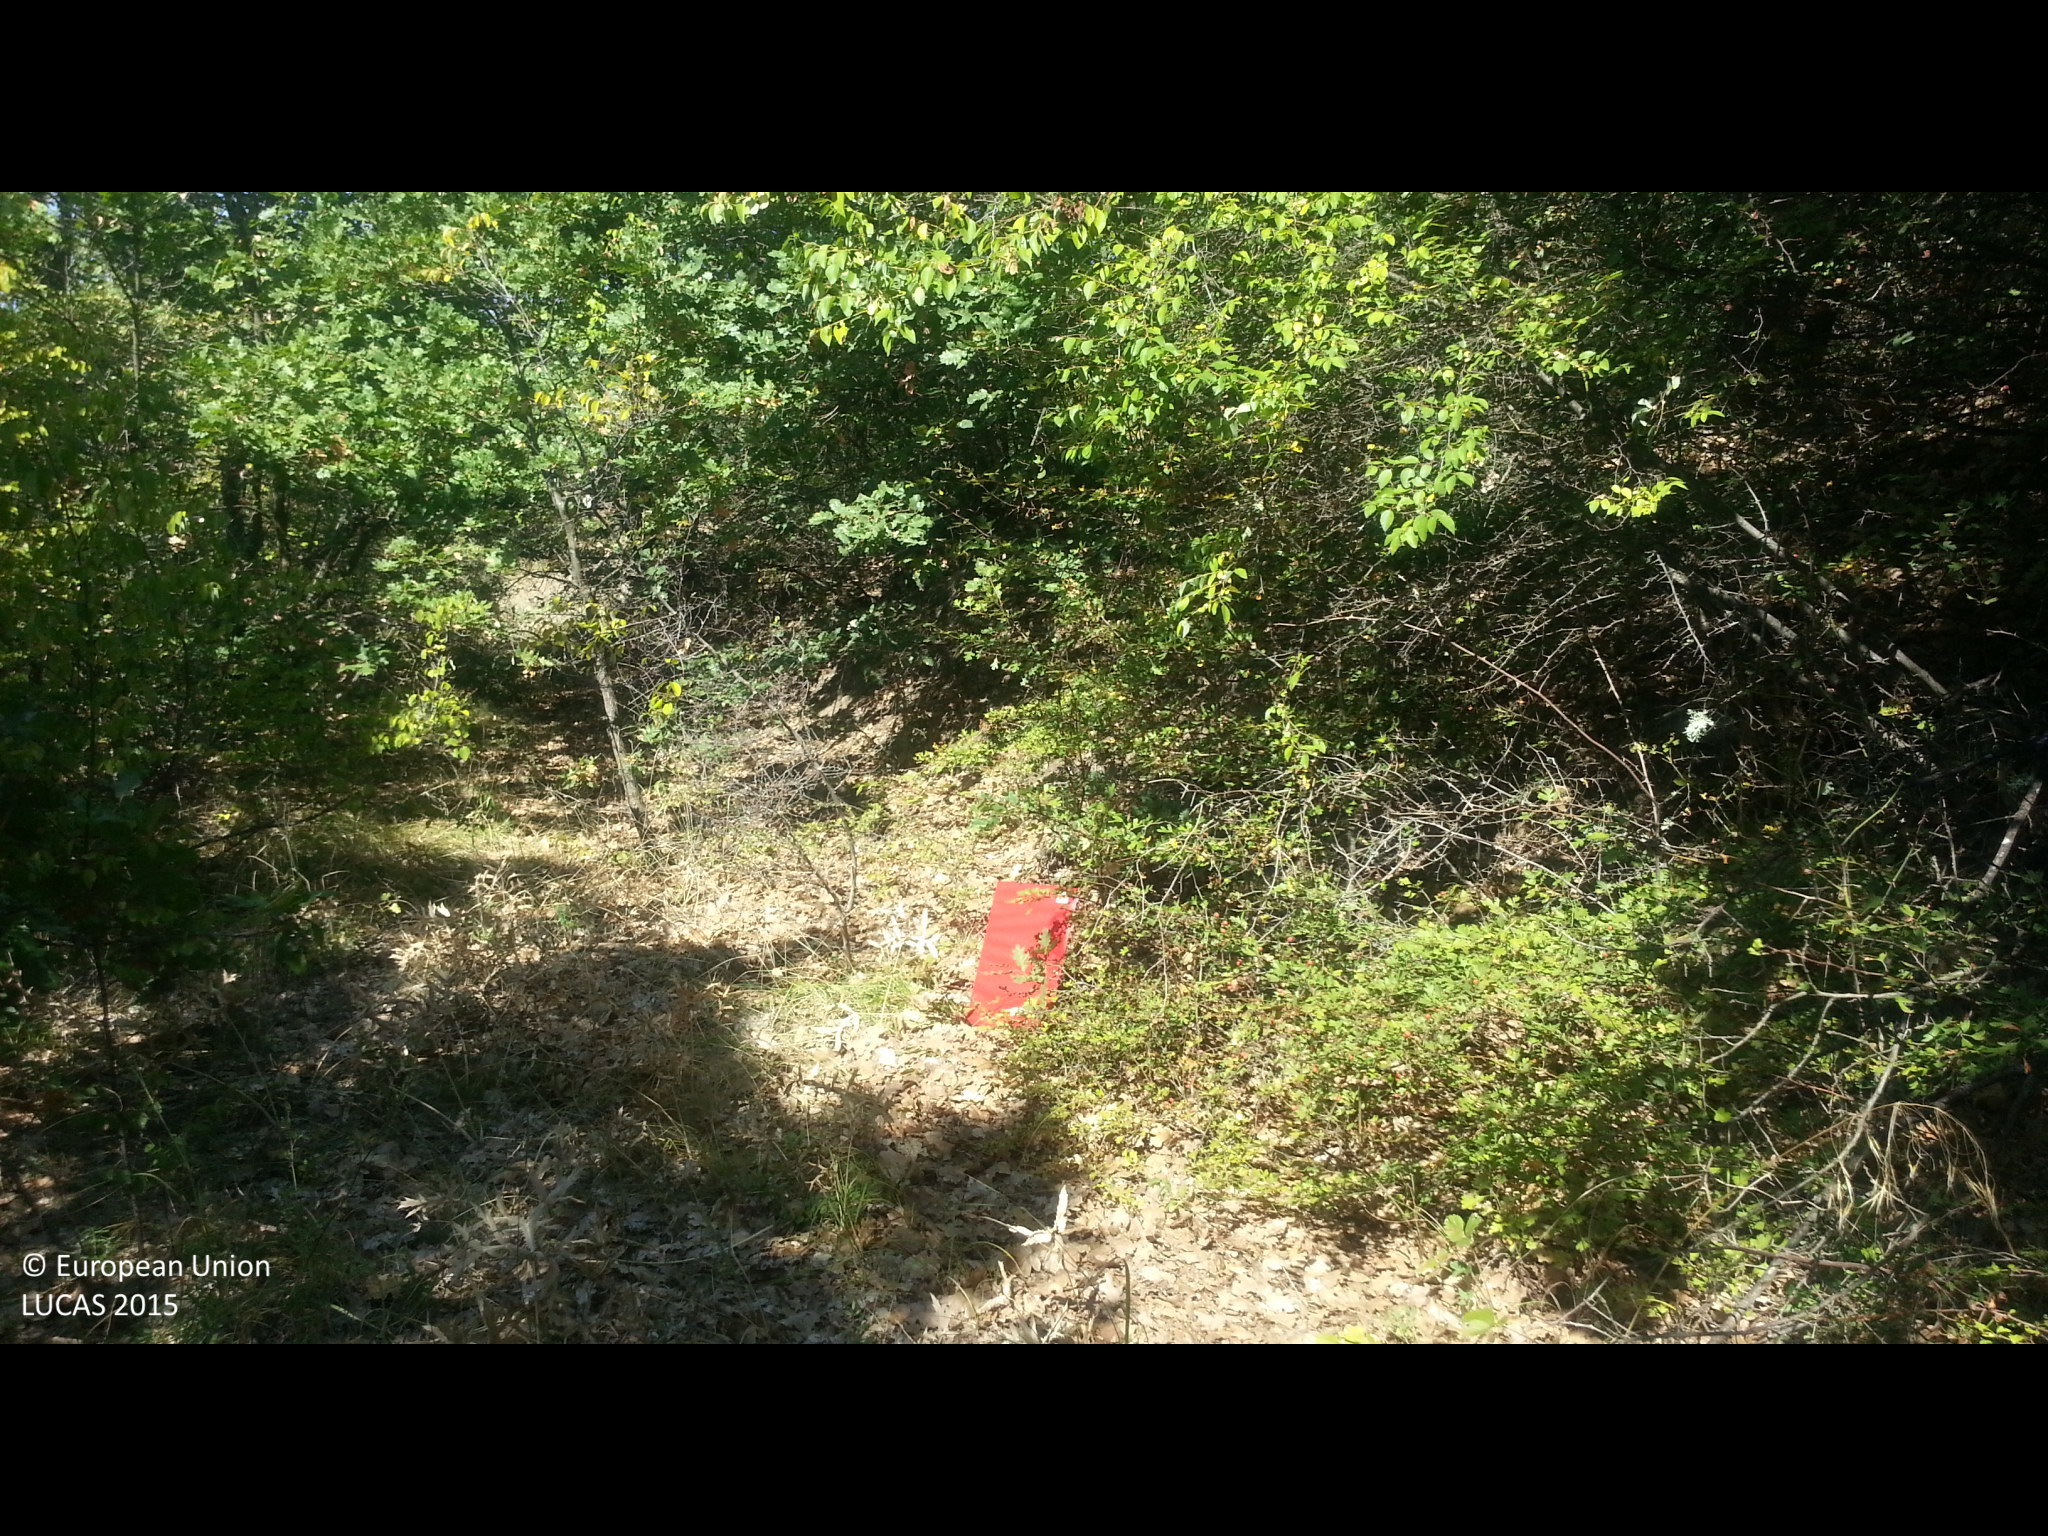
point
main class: Woodland
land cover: Broadleaved woodland
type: thermophilous deciduous forest
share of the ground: > 75 %
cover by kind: broadleaved forest trees 95 %, shrubs 5 %
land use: Forestry
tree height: > 5 m
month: September
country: BG
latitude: 42.1340
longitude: 23.0547
